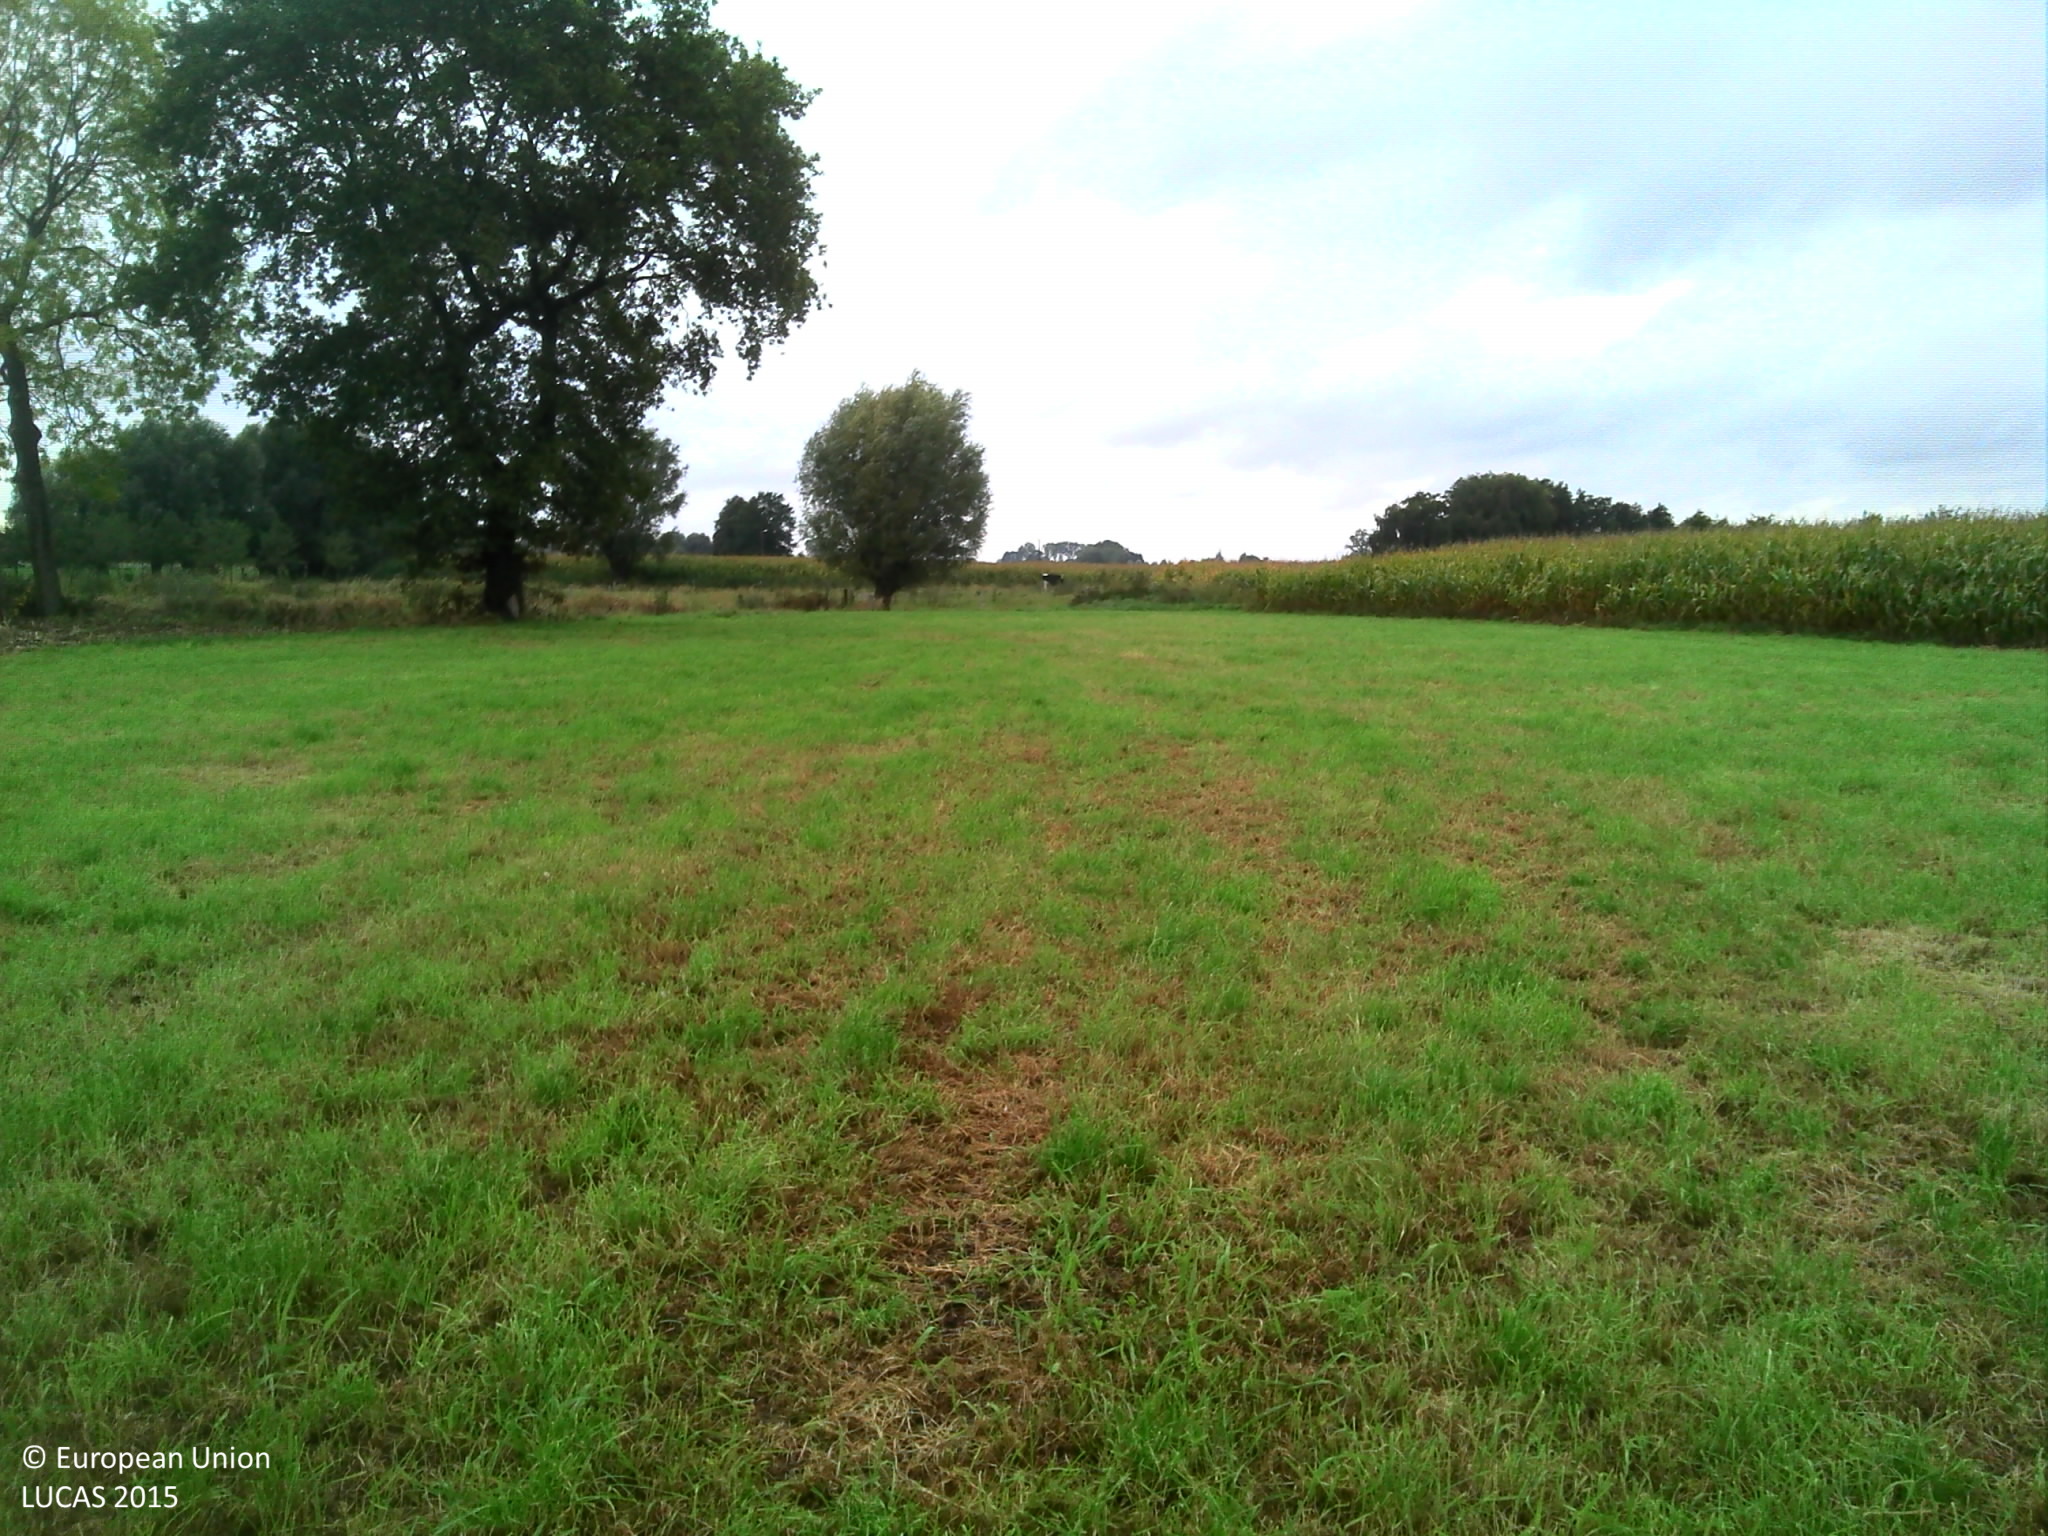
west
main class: Cropland
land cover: Temporary grasslands
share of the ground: > 75 %
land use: Agriculture (excluding fallow land and kitchen gardens)
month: October
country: BE
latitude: 50.9651
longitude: 3.0558
